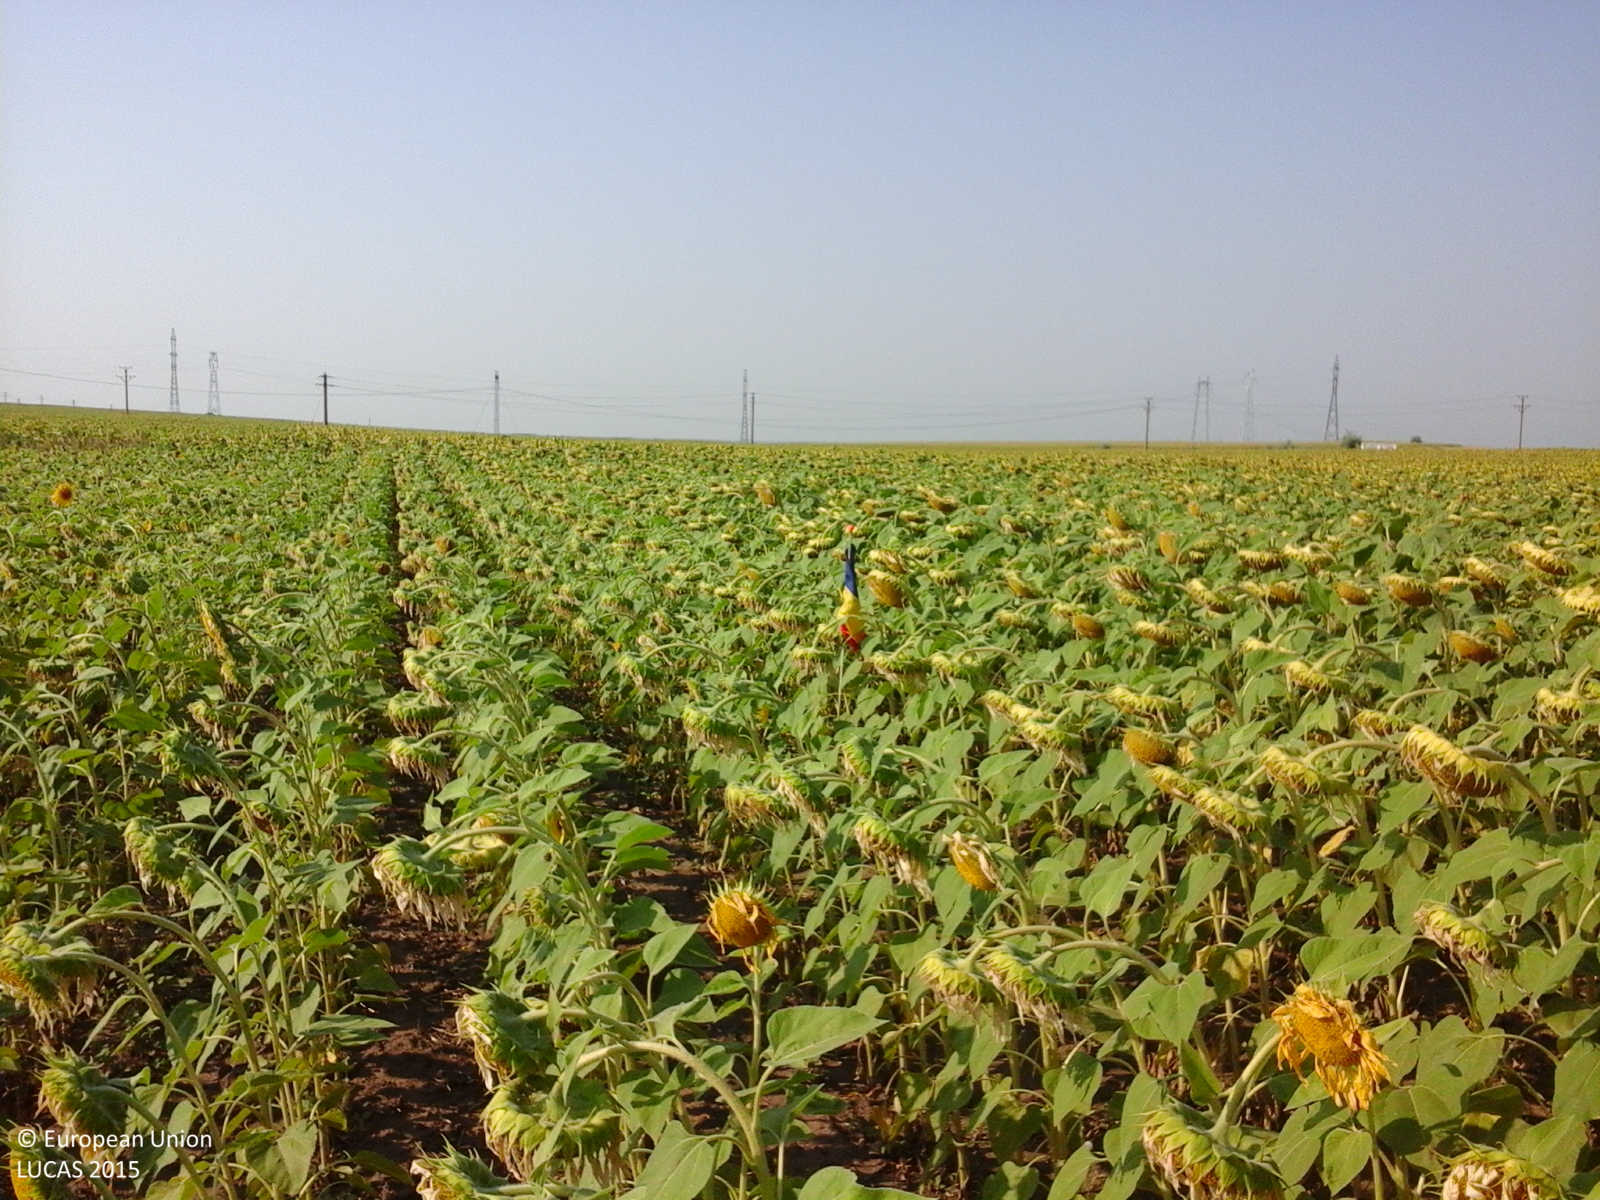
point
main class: Cropland
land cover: Sunflower
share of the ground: > 75 %
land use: Agriculture (excluding fallow land and kitchen gardens)
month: July
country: RO
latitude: 45.5299
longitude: 27.7680
